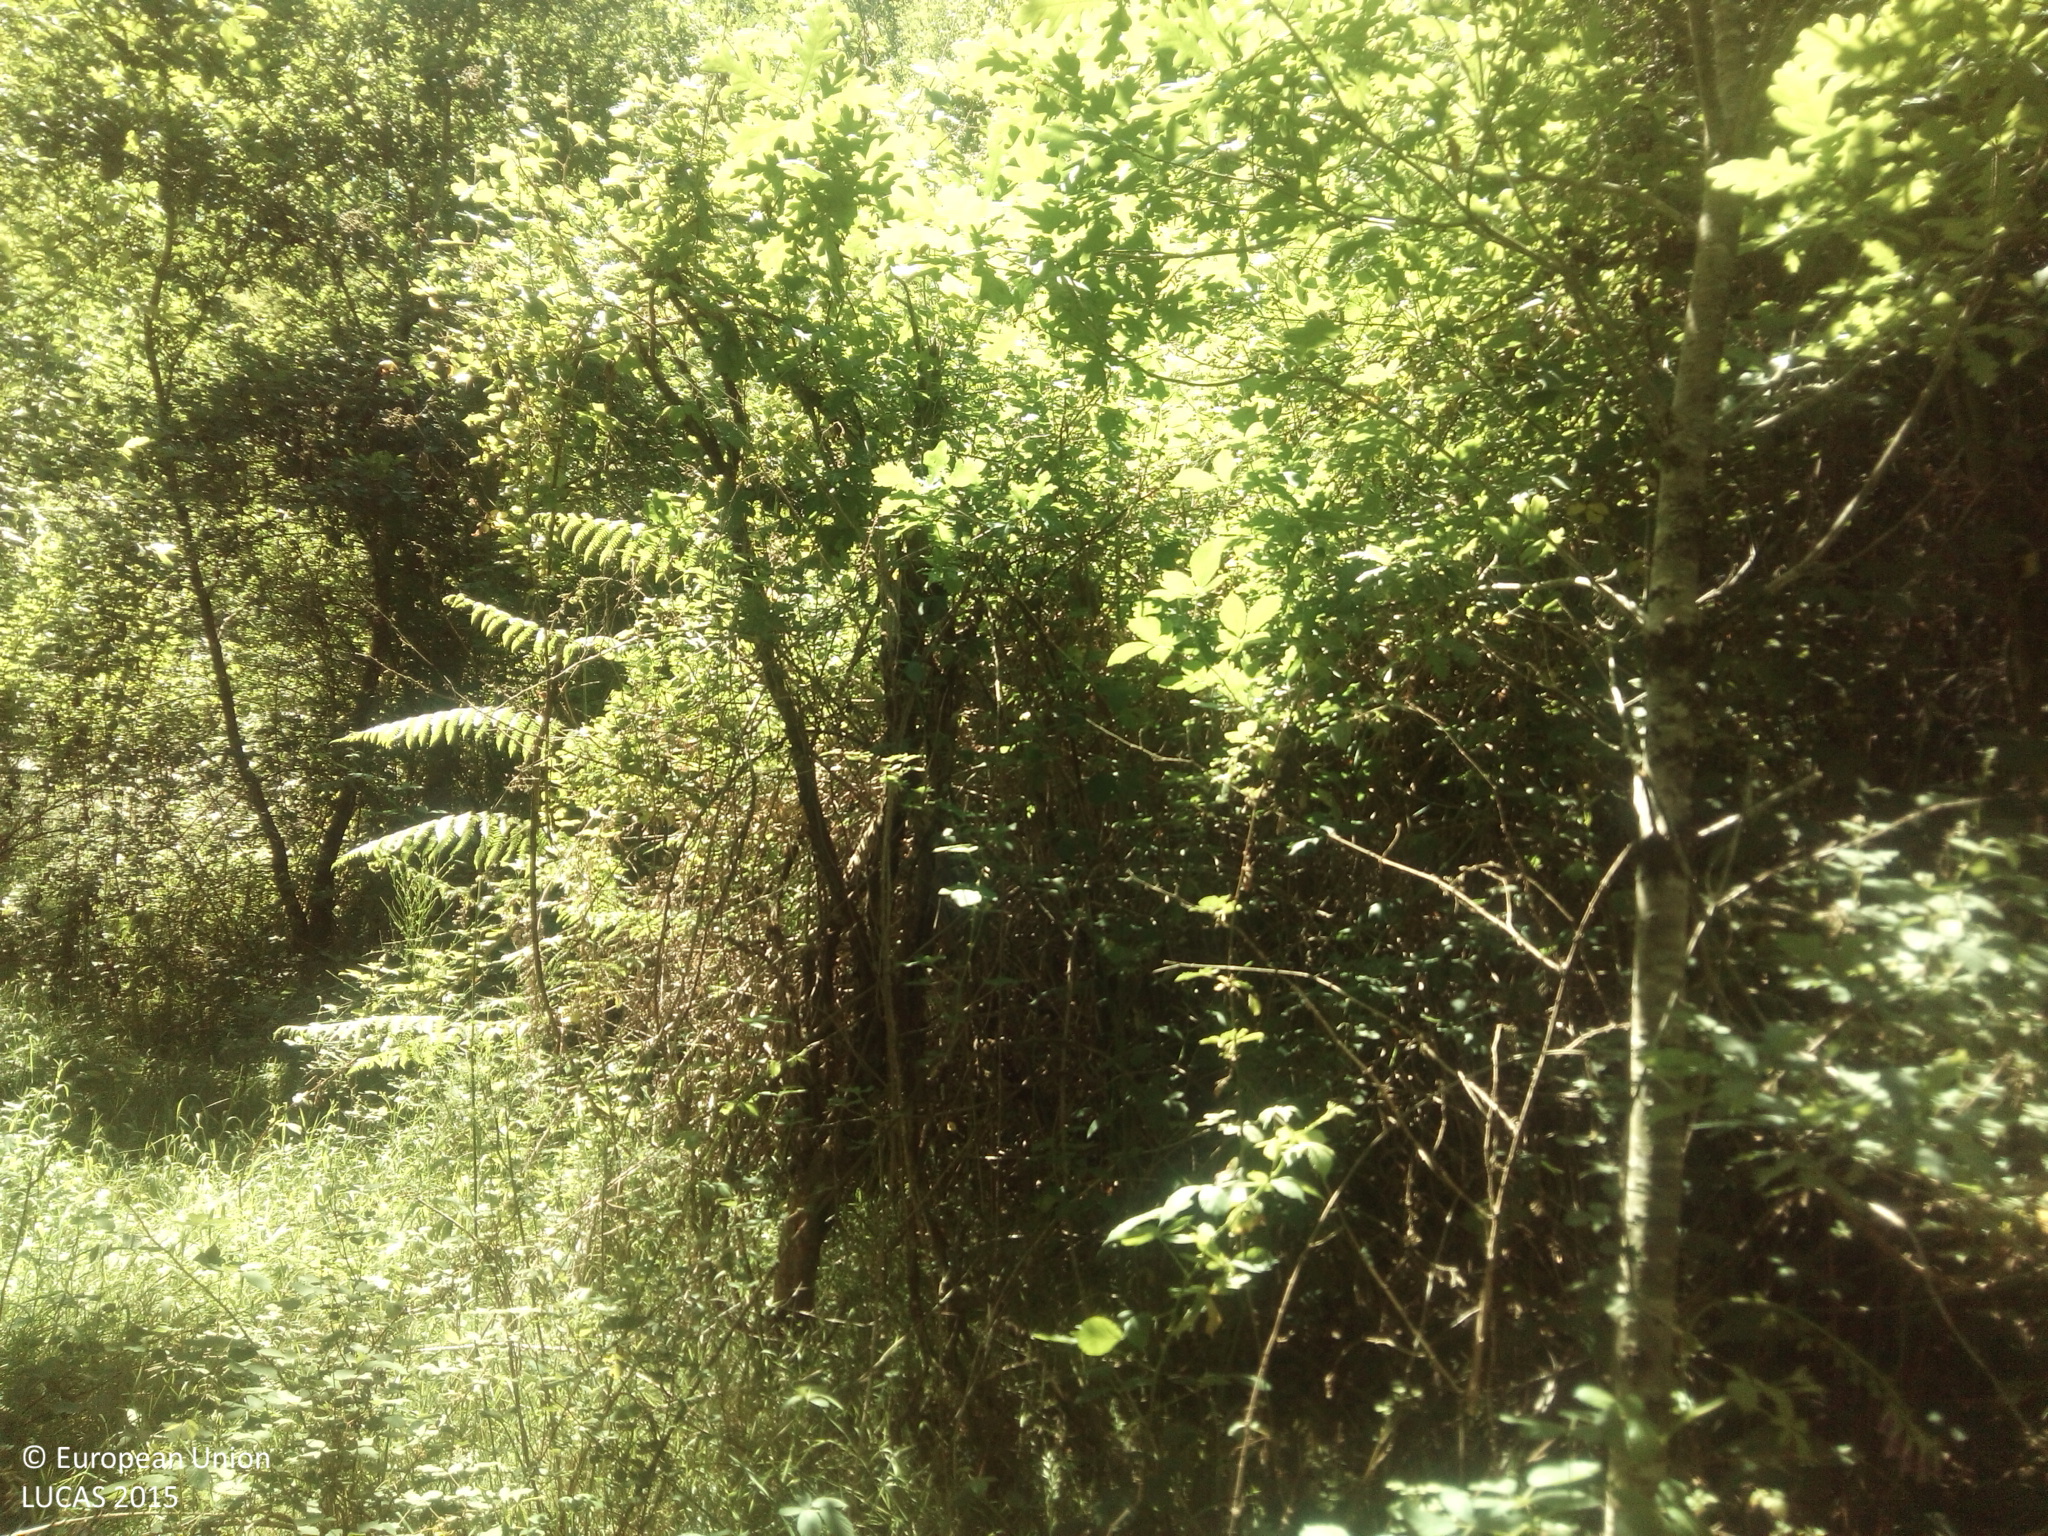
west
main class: Woodland
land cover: Broadleaved woodland
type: acidophilous oak and oak-birch forest
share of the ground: > 75 %
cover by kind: broadleaved forest trees 100 %
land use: Forestry
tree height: > 5 m
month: June
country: ES
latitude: 42.4793
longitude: -8.3272
